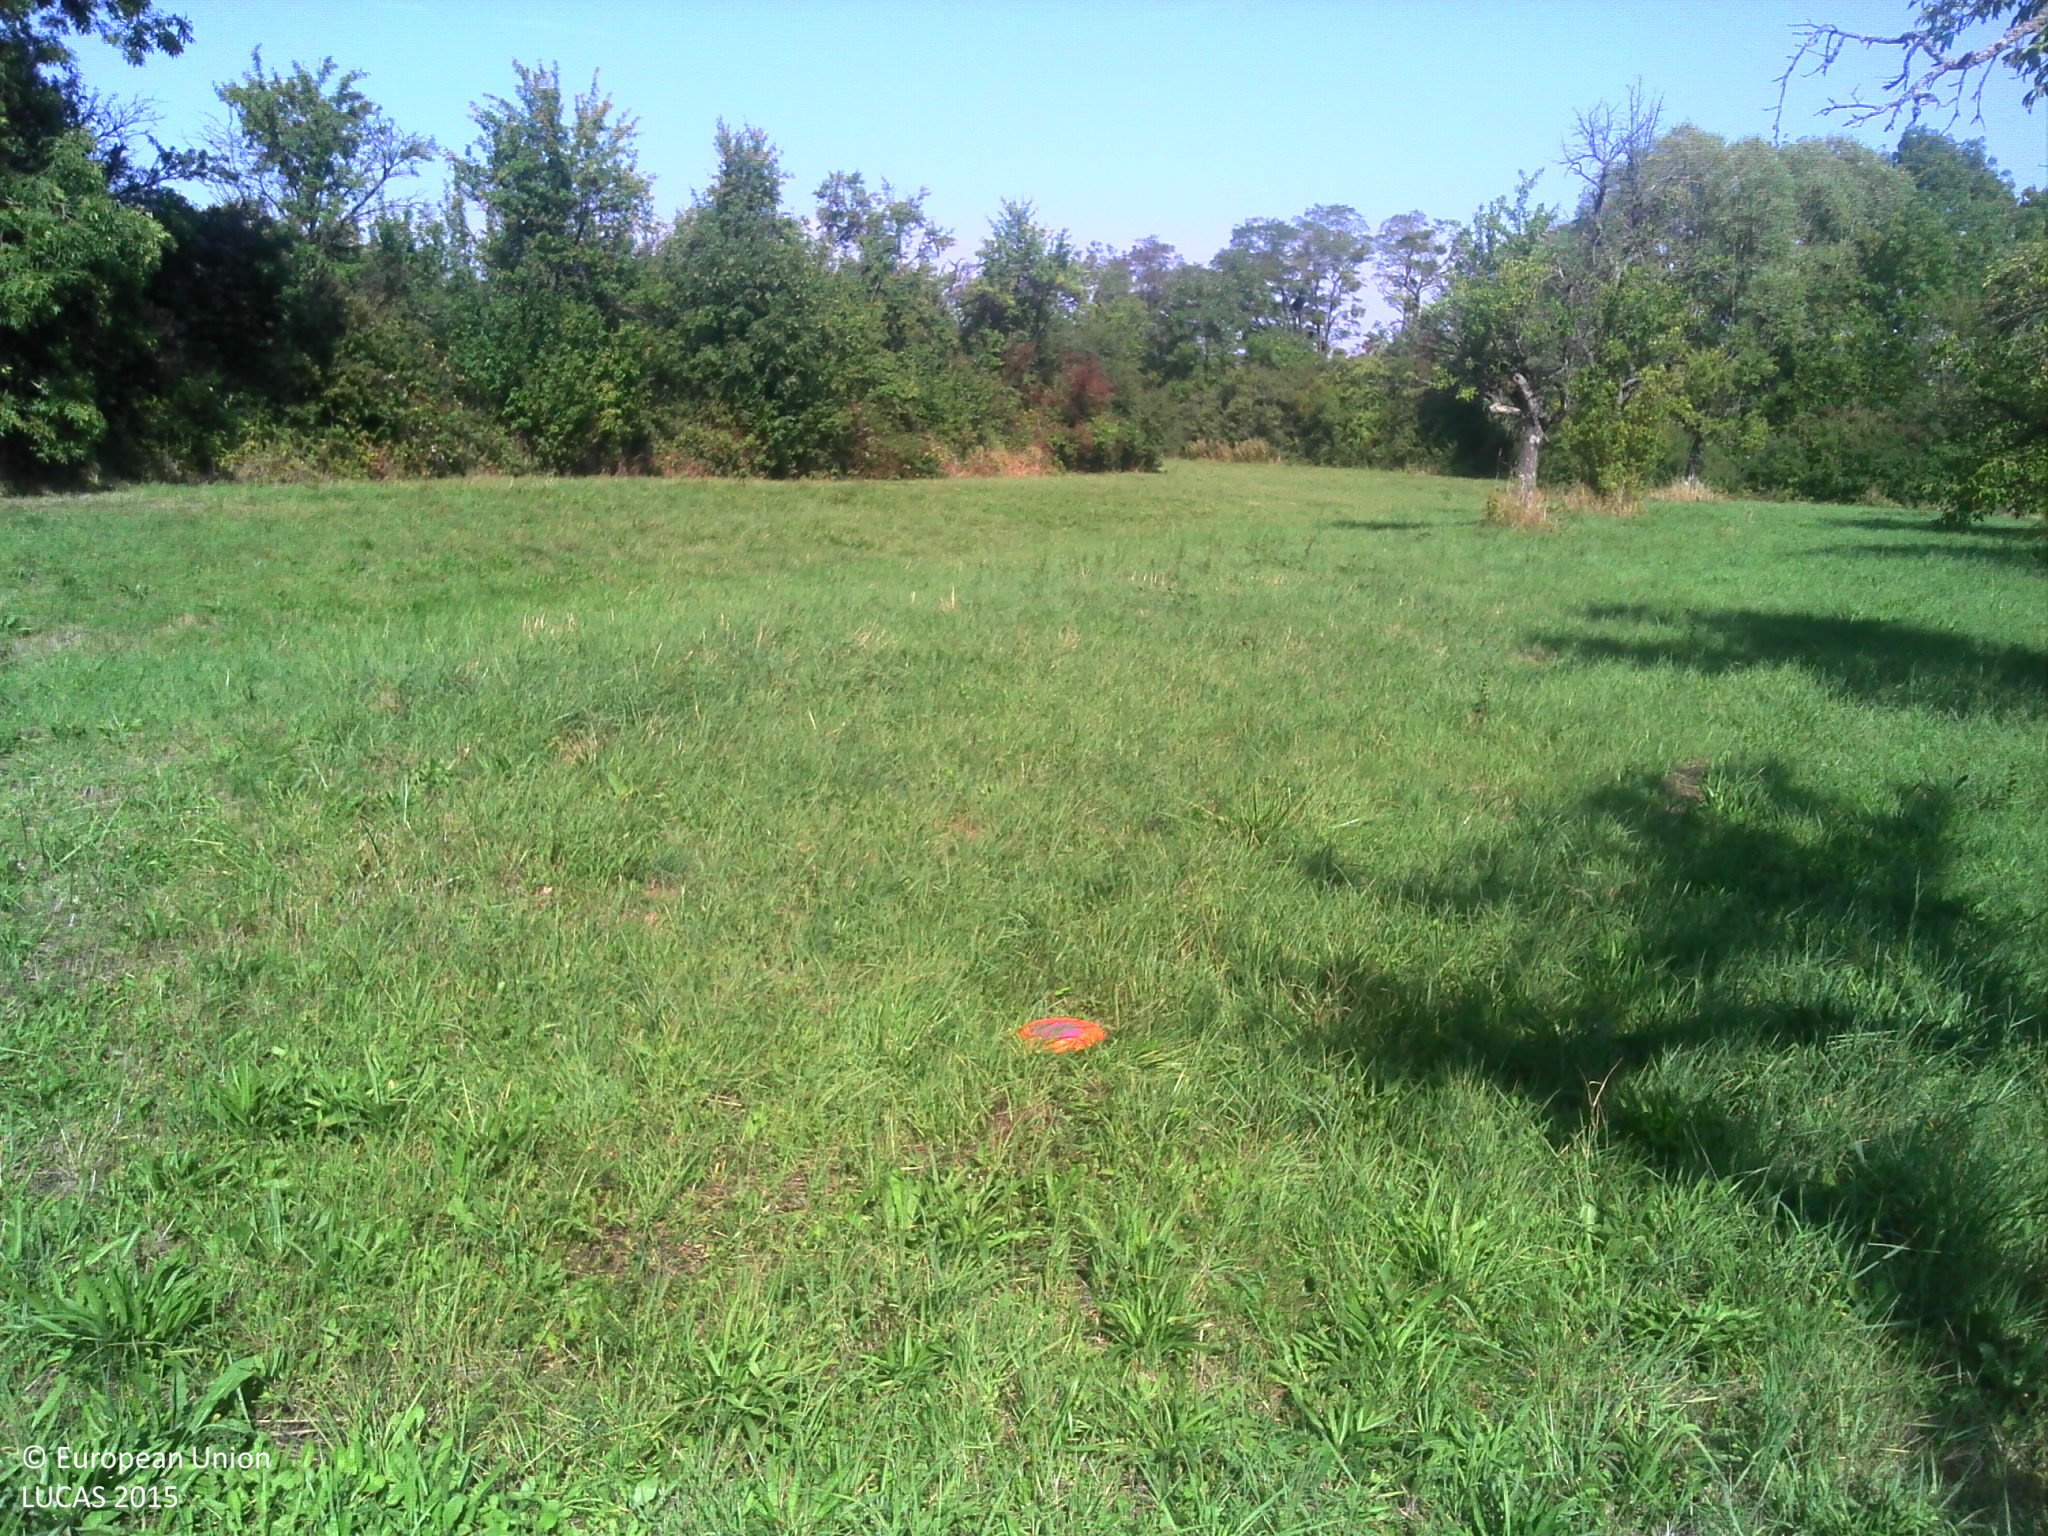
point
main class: Cropland
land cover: Other fruit trees and berries
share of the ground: > 75 %
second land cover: Grassland without tree/shrub cover
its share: > 75 %
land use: Agriculture (excluding fallow land and kitchen gardens)
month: September
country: FR
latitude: 48.8264
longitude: 6.2541
